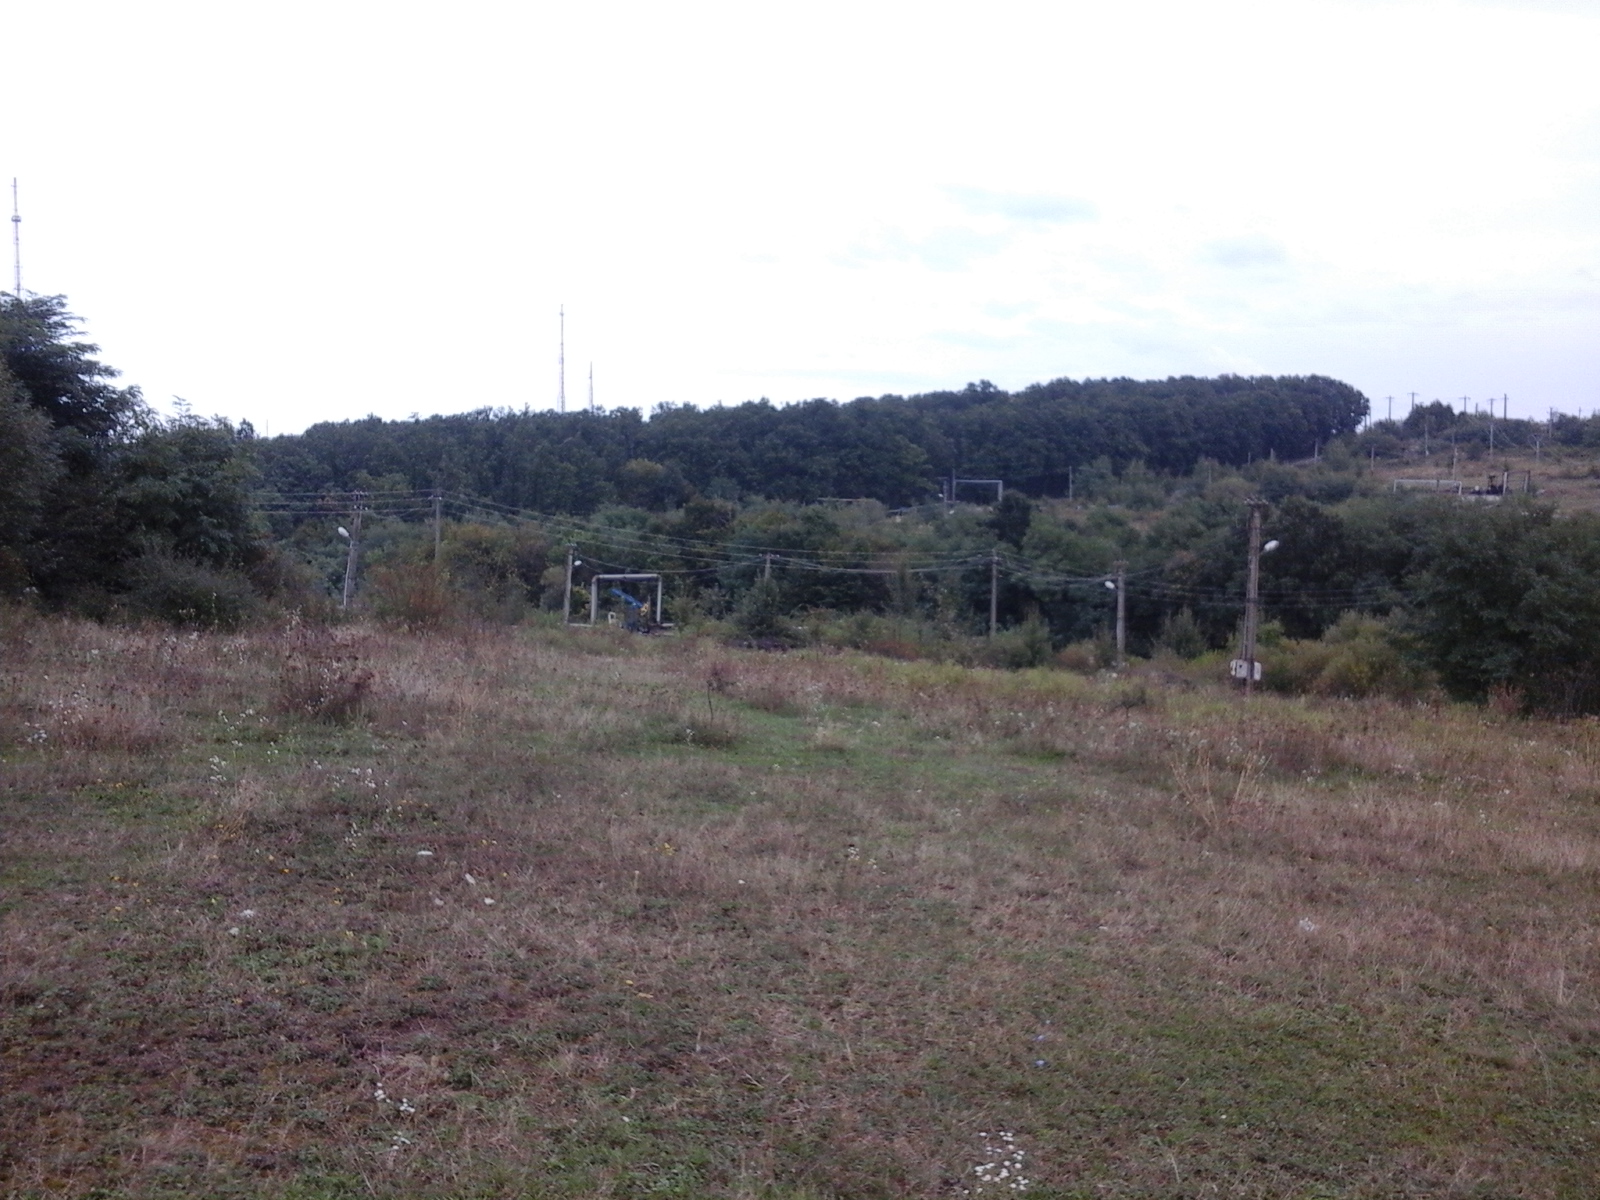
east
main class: Grassland
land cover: Grassland without tree/shrub cover
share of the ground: > 75 %
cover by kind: herbaceous plants 100 %
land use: Agriculture (excluding fallow land and kitchen gardens)
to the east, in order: Grassland without tree/shrub cover; Electric lines; Grassland without tree/shrub cover; Tracks; Spontaneously vegetated surfaces; Electric lines; Spontaneously vegetated surfaces; Tracks; Grassland with sparse tree/shrub cover; Other structural elements; Grassland with sparse tree/shrub cover; Abandoned hedges; Tracks; Broadleaved woodland
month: September
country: RO
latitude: 47.2550
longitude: 22.4899
